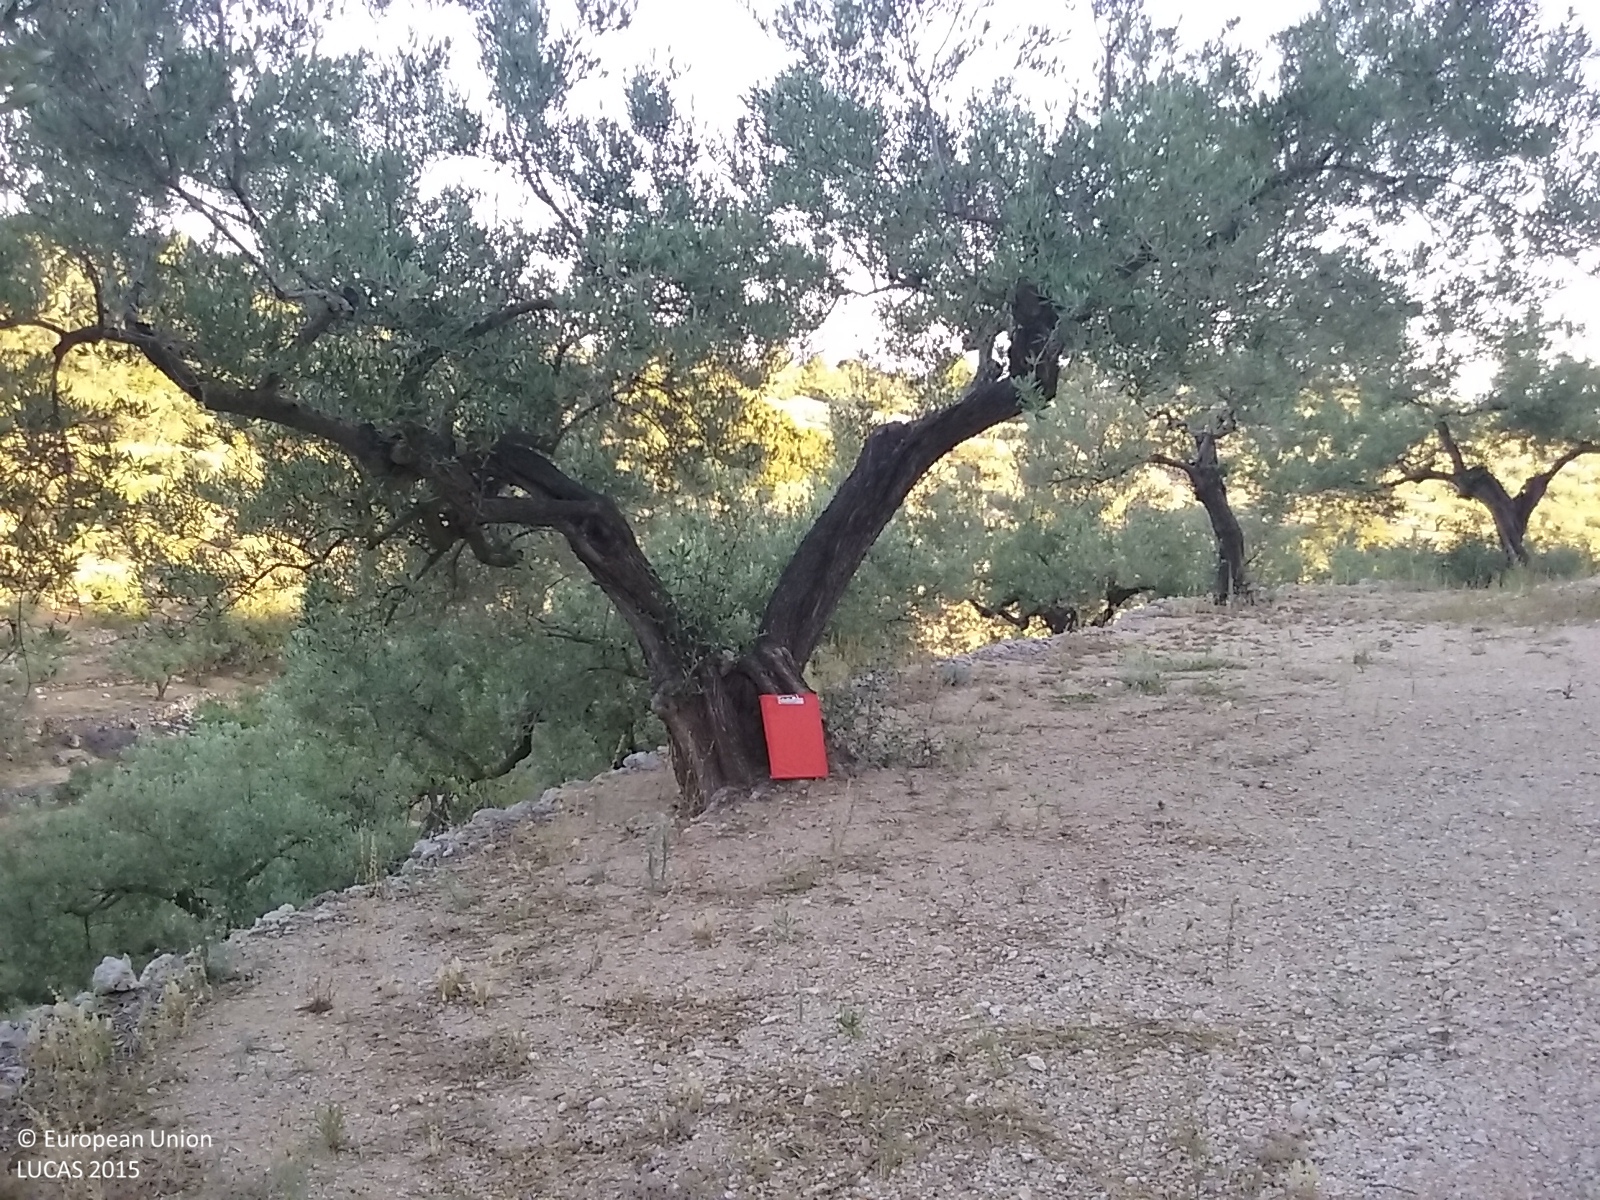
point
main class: Cropland
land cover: Olive groves
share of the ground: 25 - 50 %
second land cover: Spontaneously vegetated surfaces
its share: 10 - 25 %
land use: Agriculture (excluding fallow land and kitchen gardens)
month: May
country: ES
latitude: 40.7929
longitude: 0.5485
